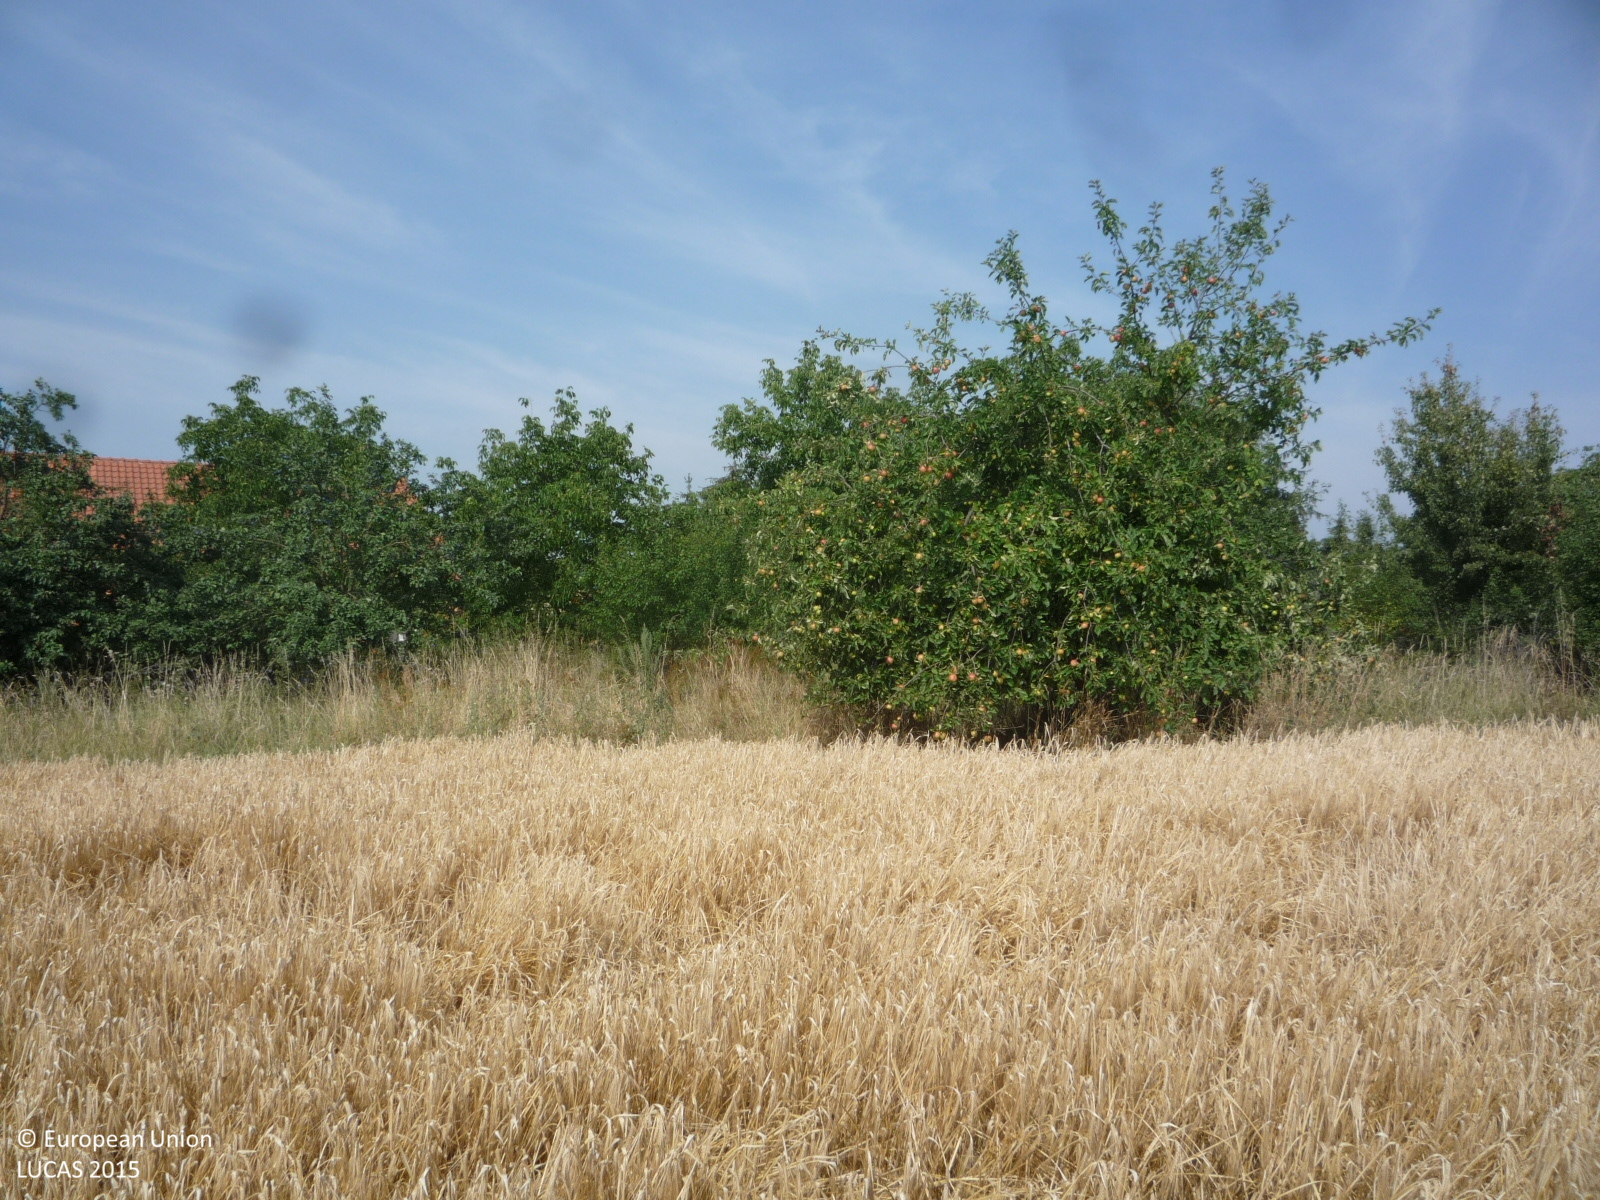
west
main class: Cropland
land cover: Barley
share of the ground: > 75 %
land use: Agriculture (excluding fallow land and kitchen gardens)
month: August
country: CZ
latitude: 49.9674
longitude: 14.9798
